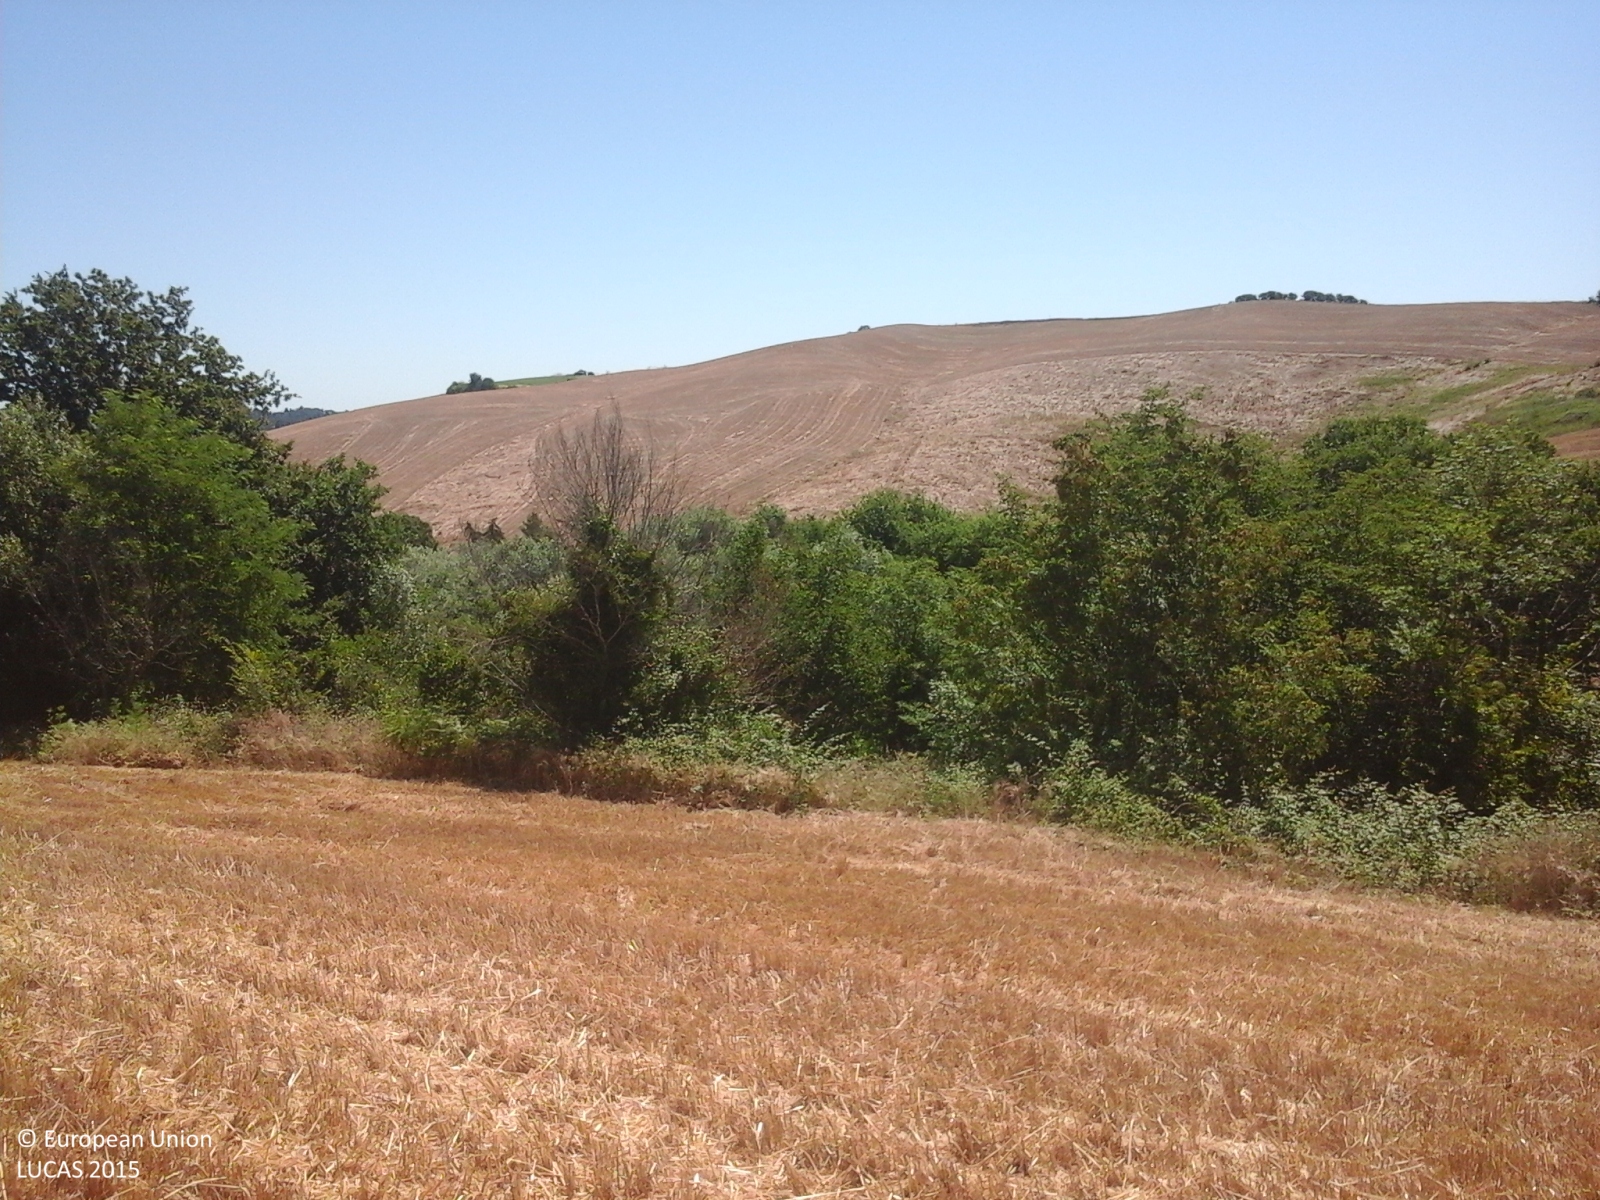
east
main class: Cropland
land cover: Durum wheat
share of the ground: > 75 %
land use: Agriculture (excluding fallow land and kitchen gardens)
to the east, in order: Durum wheat; Broadleaved woodland; Ditches and canals; Broadleaved woodland; Temporary grasslands
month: June
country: IT
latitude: 43.5369
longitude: 10.6047
